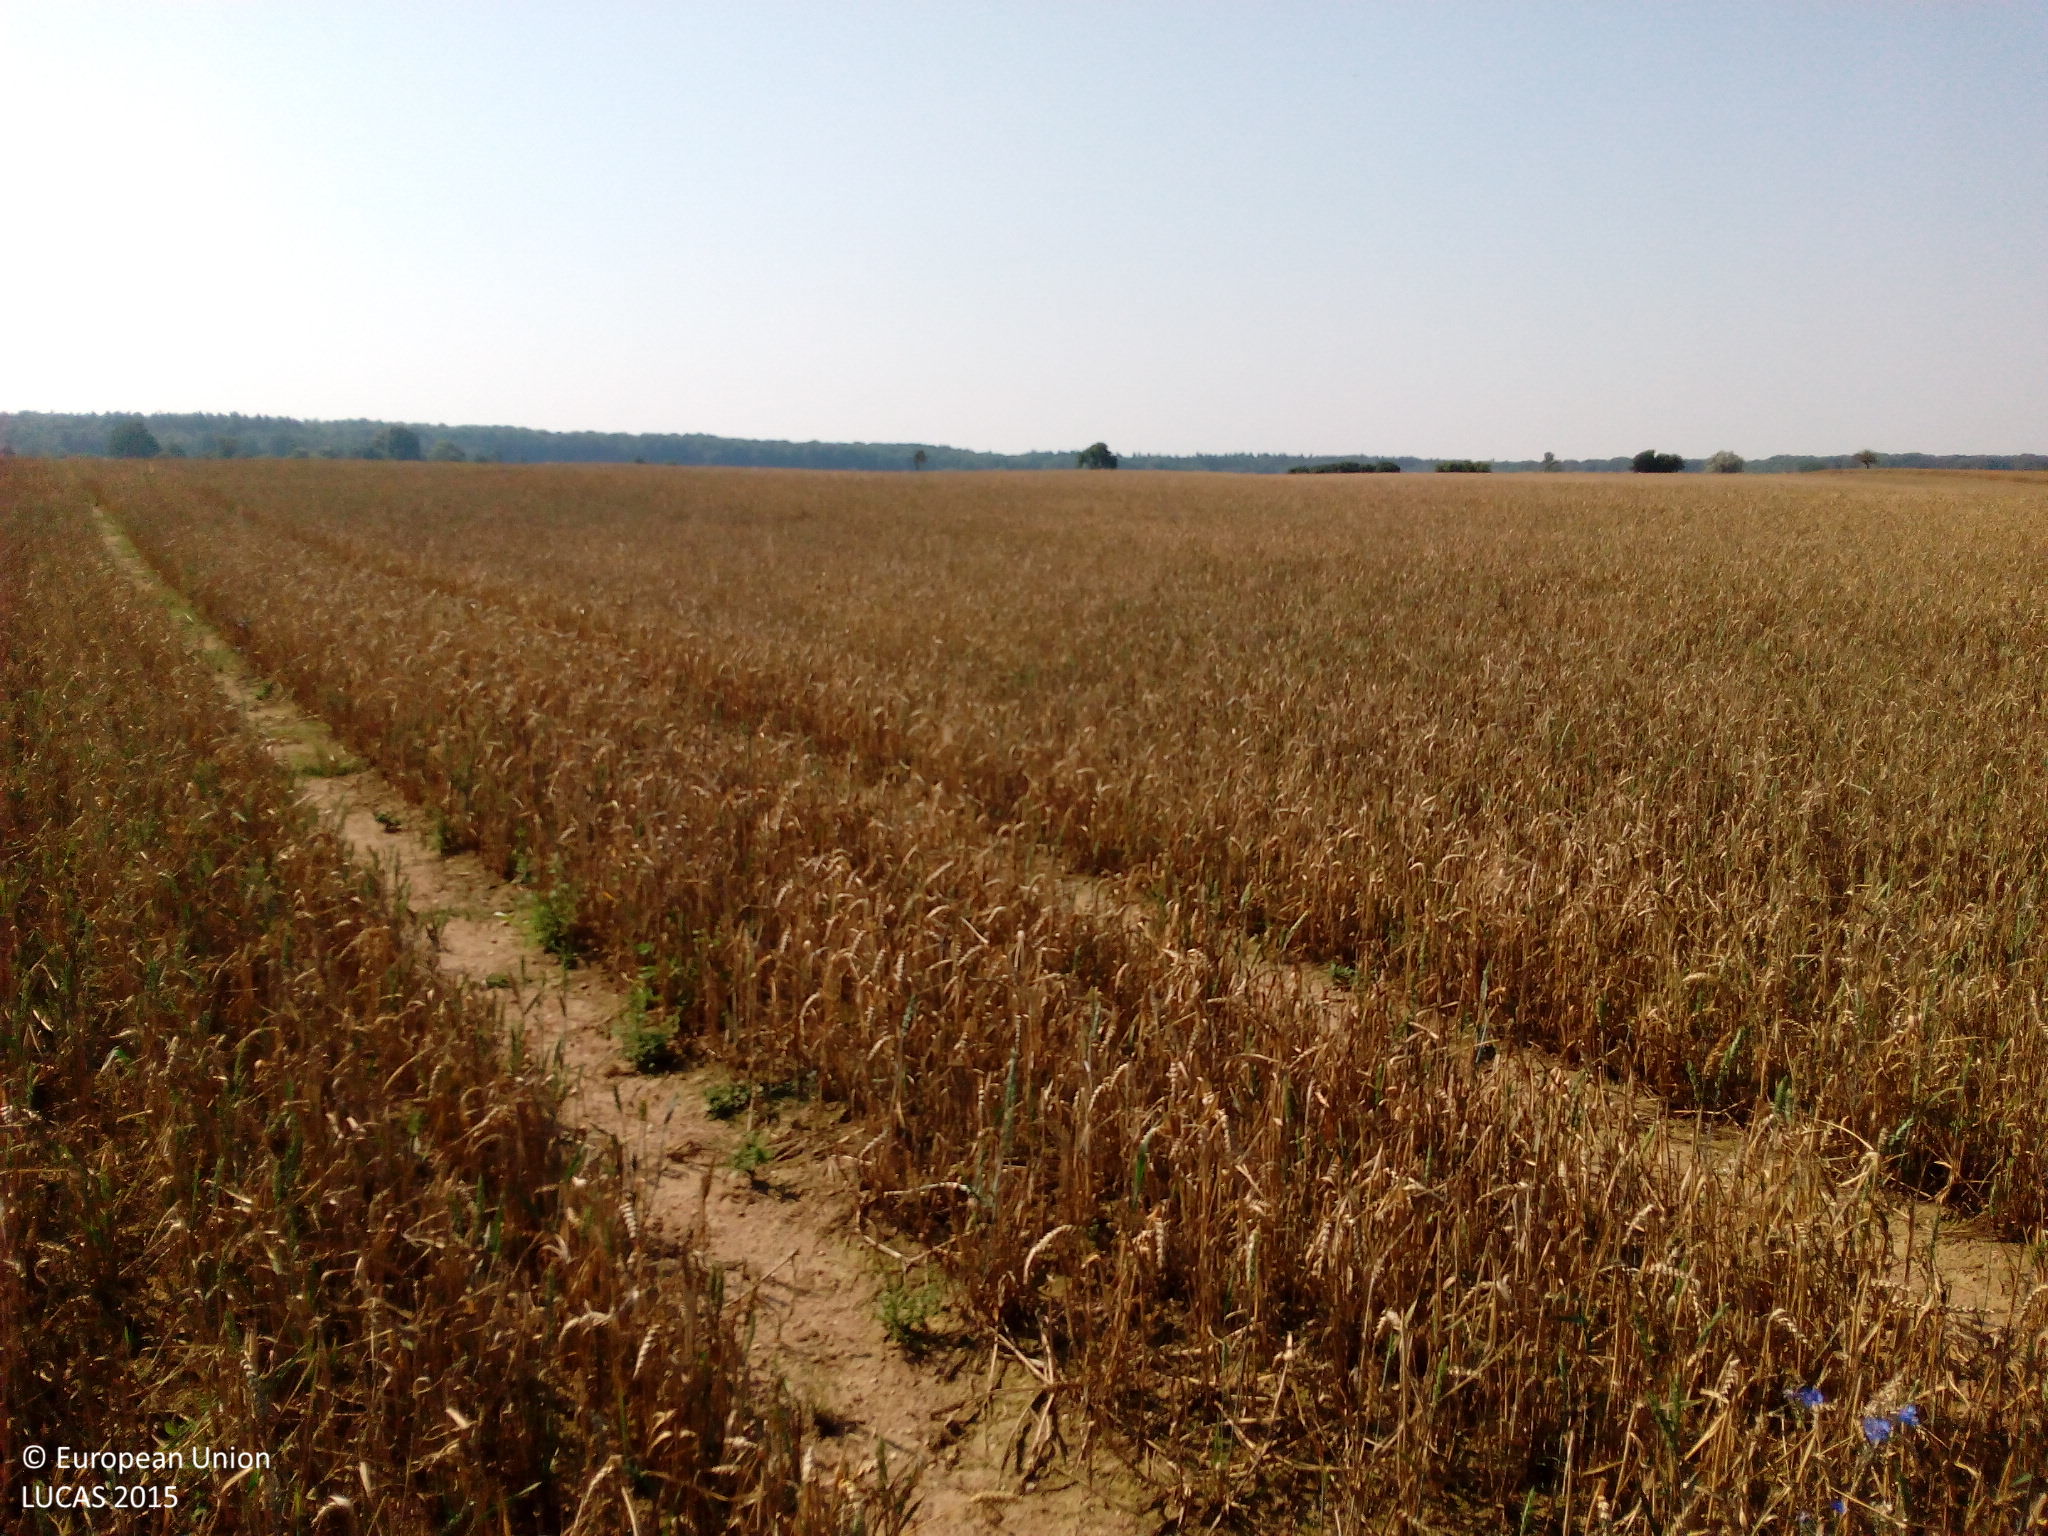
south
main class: Cropland
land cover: Common wheat
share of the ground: 25 - 50 %
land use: Agriculture (excluding fallow land and kitchen gardens)
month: August
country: DE
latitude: 53.2949
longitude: 13.5857
